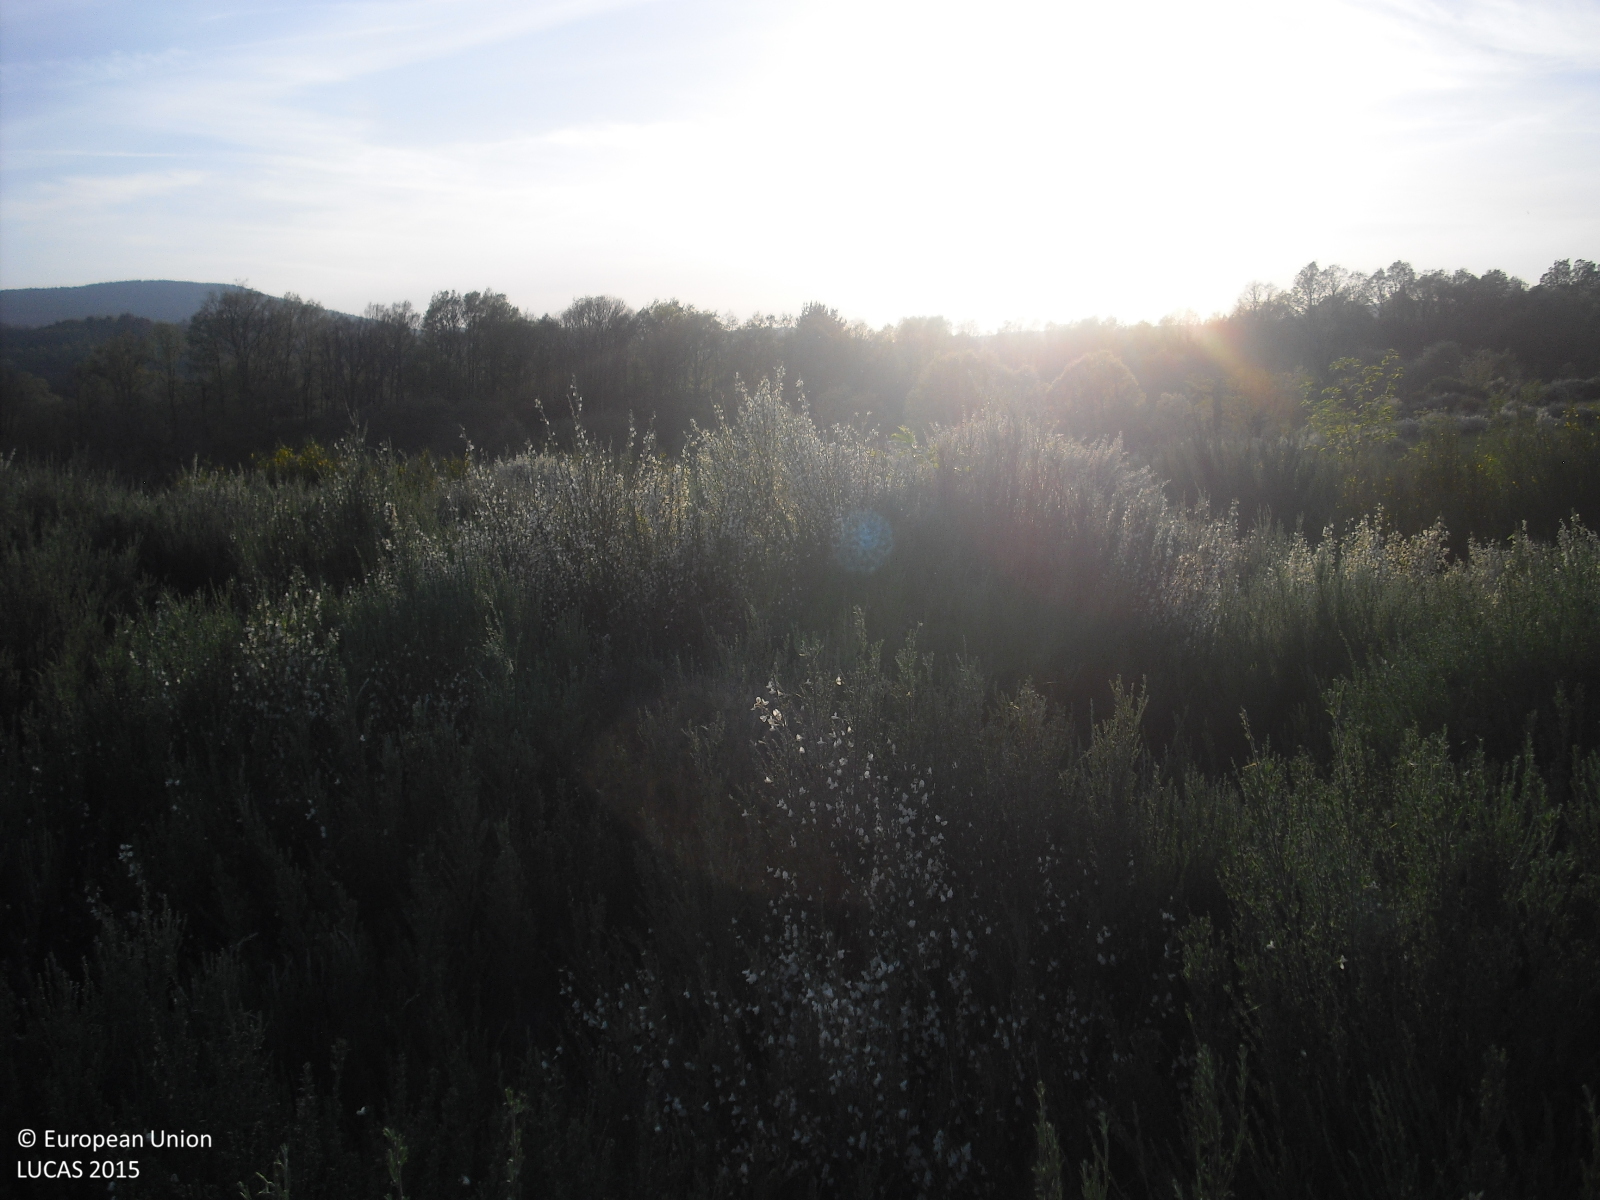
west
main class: Shrubland
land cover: Shrubland without tree cover
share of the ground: > 75 %
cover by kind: shrubs 80 %, herbaceous plants 20 %
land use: Abandoned areas
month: May
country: ES
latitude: 42.0022
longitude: -7.2853
